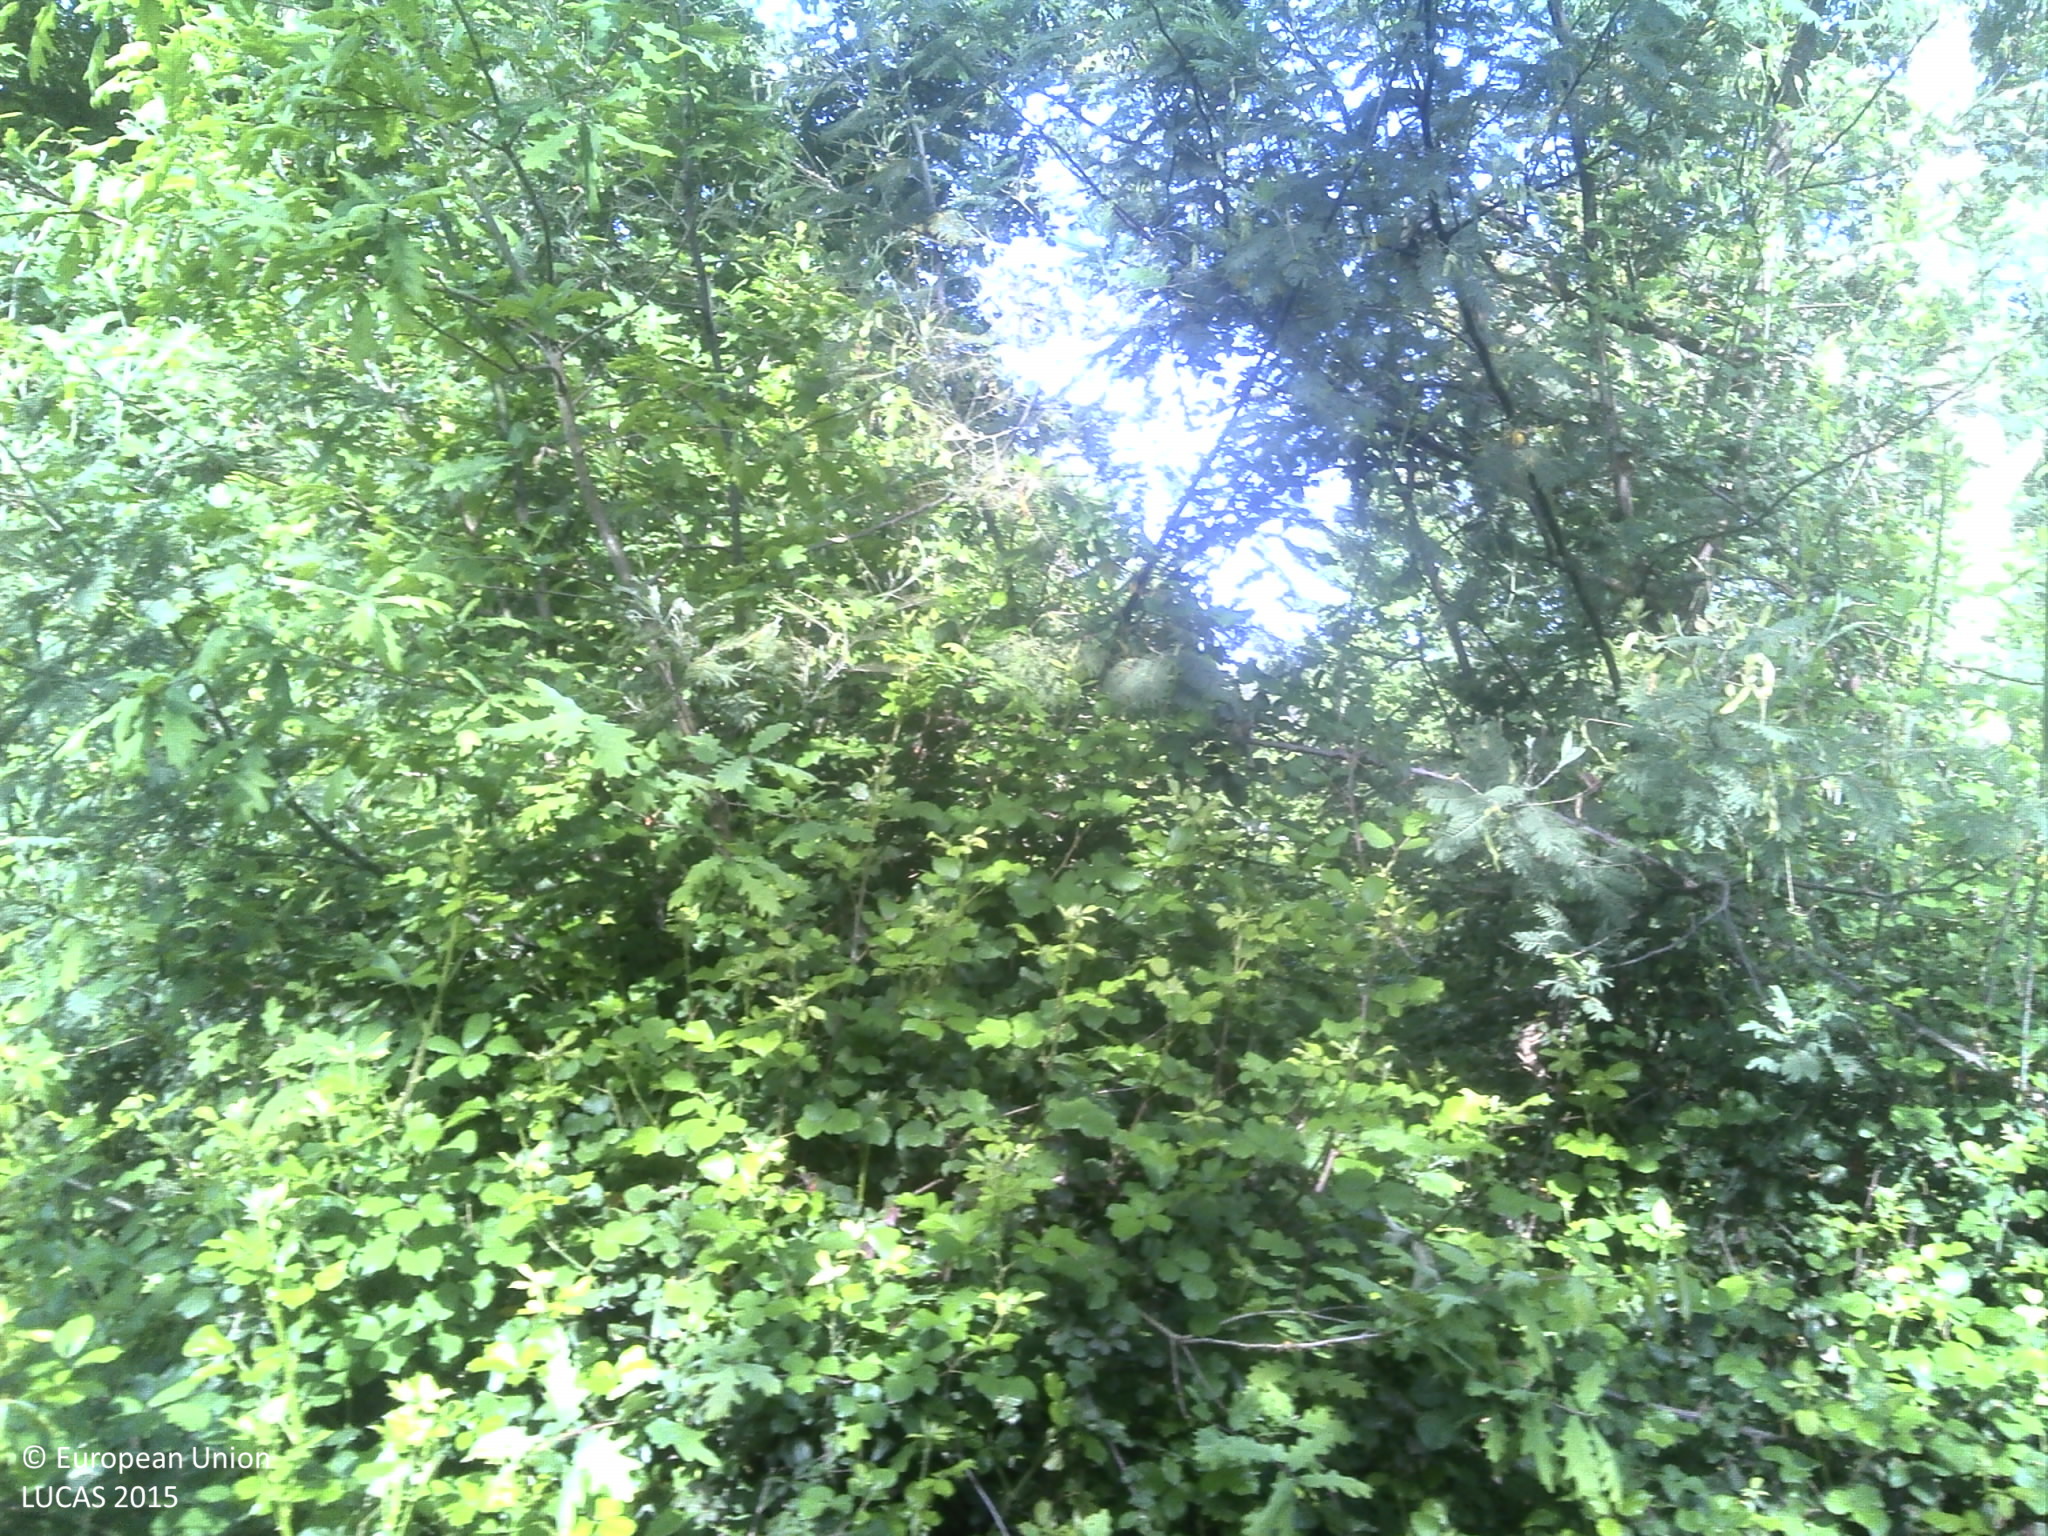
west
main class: Woodland
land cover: Broadleaved woodland
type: acidophilous oak and oak-birch forest
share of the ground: 25 - 50 %
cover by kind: broadleaved forest trees 50 %, shrubs 25 %, herbaceous plants 15 %, unconsolidated bare surface 10 %
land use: Forestry
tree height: > 5 m
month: May
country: PT
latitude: 40.6599
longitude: -7.7800
